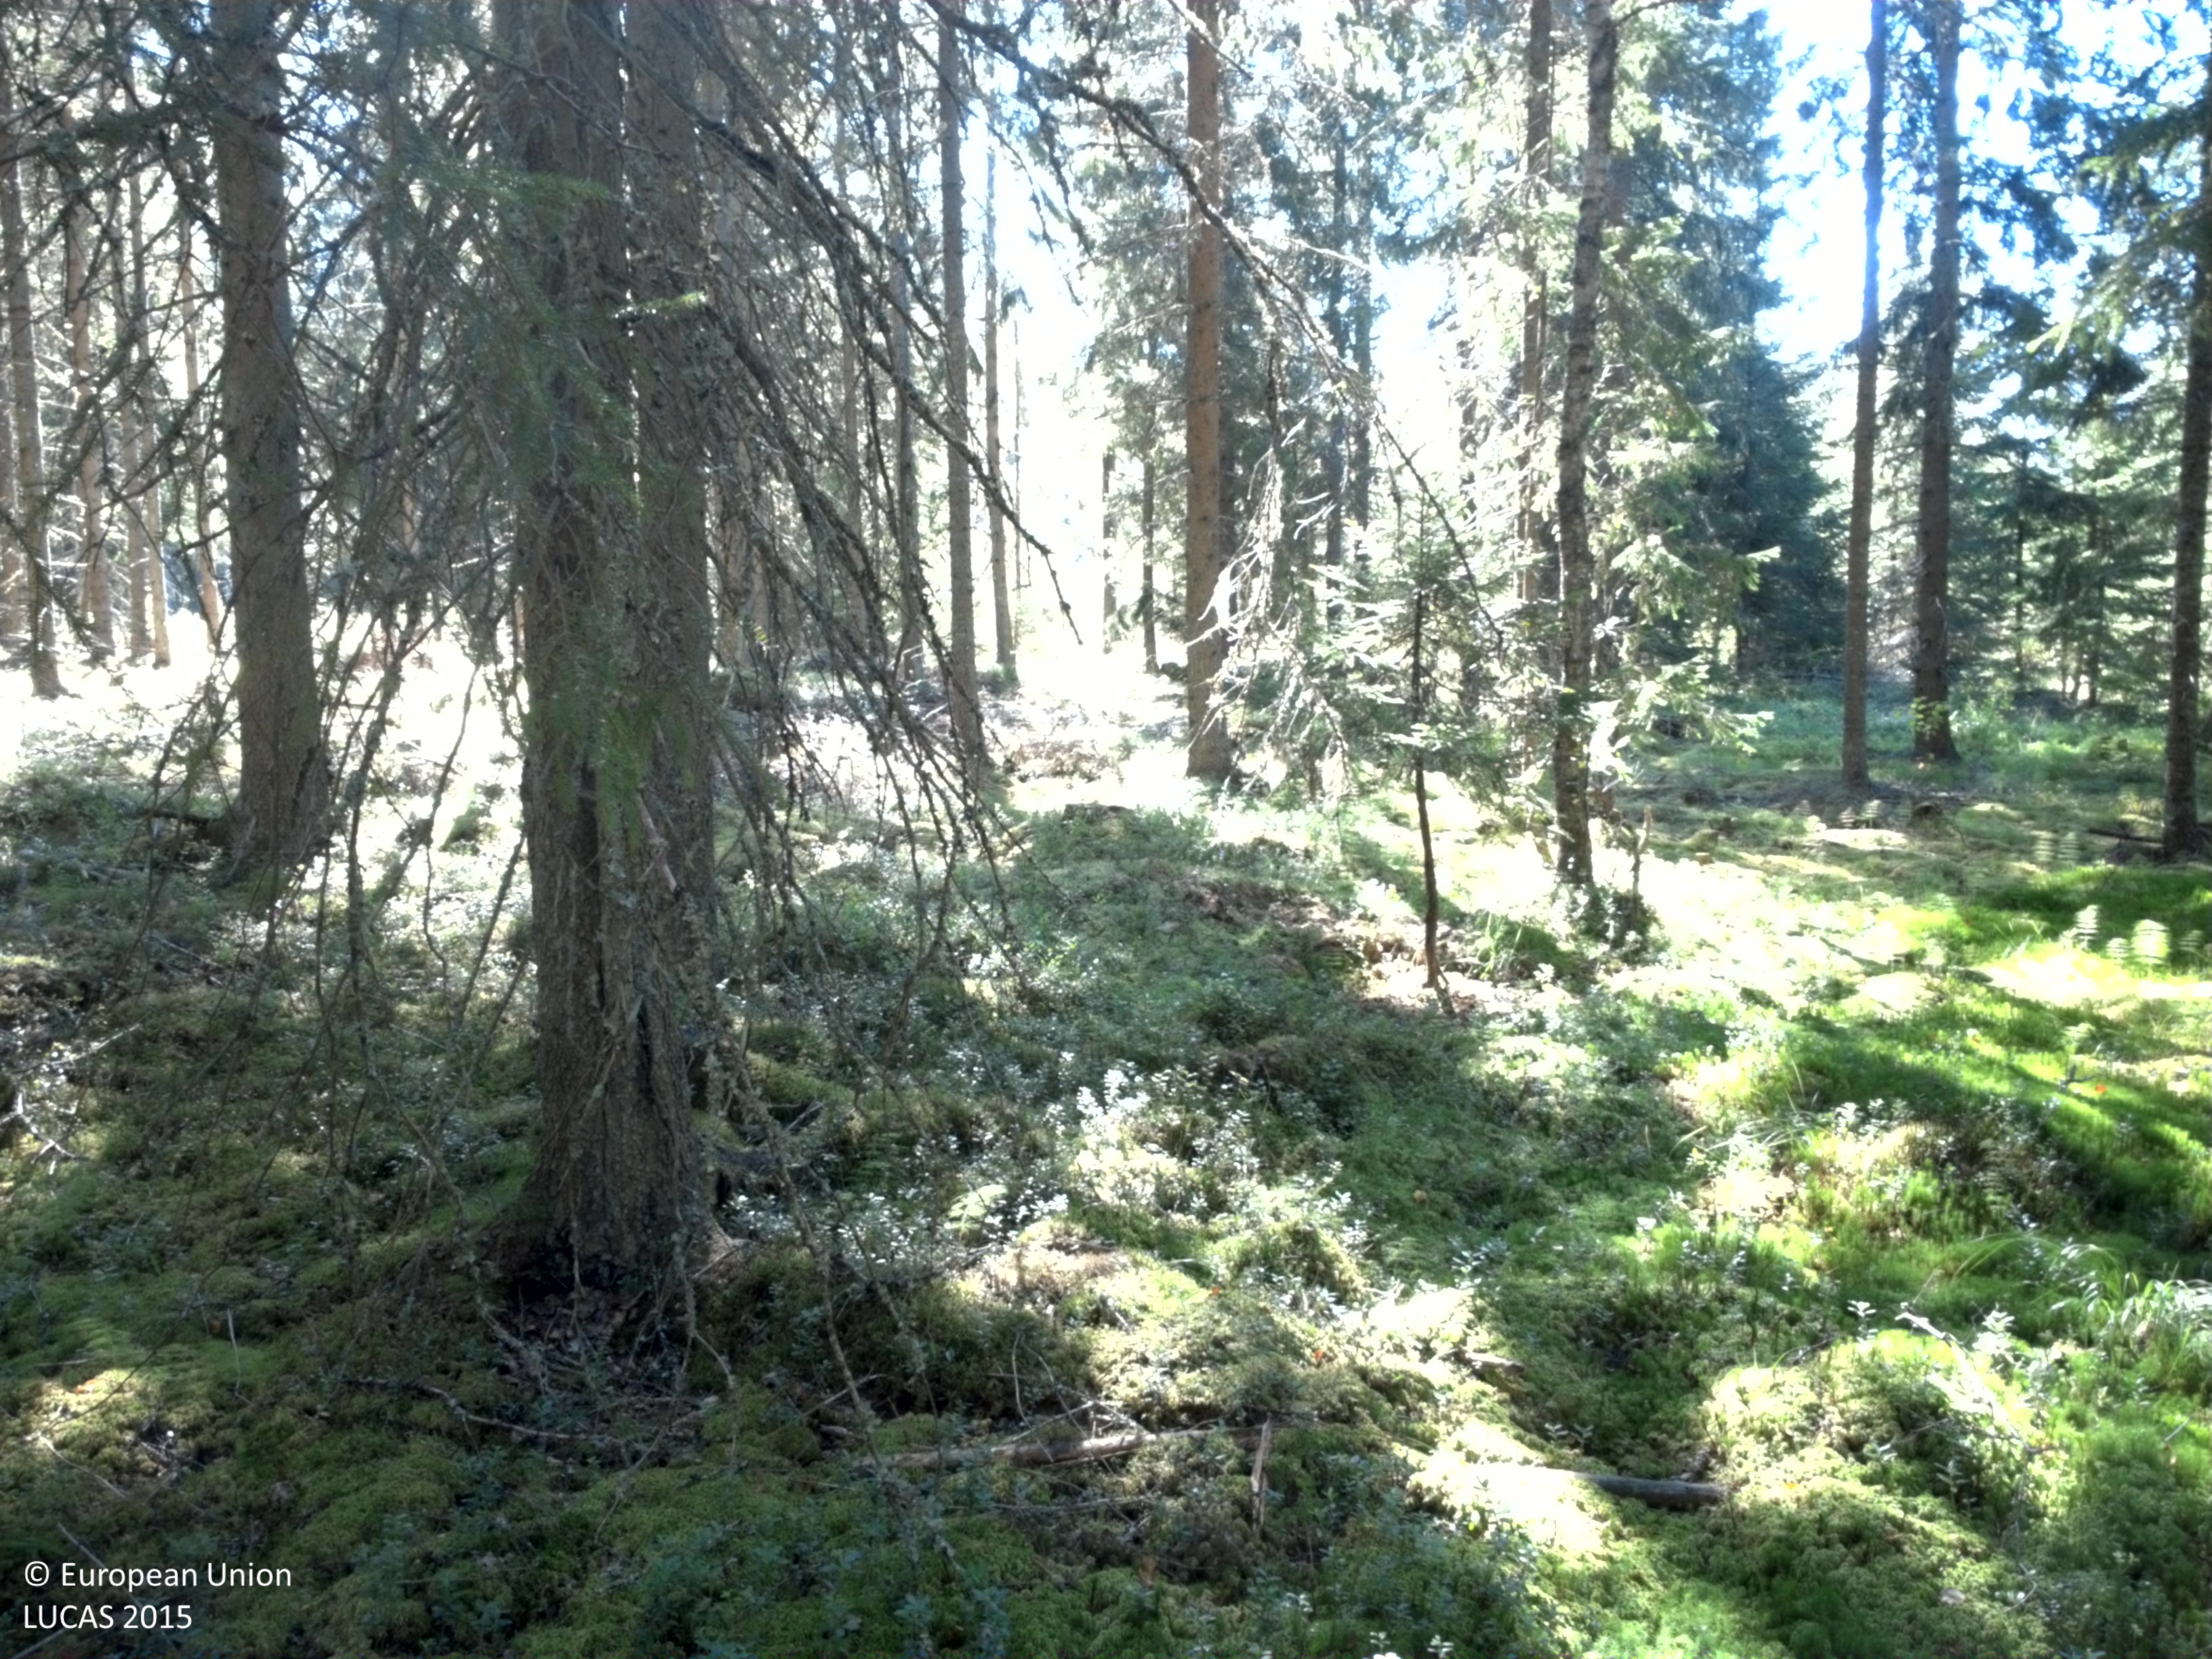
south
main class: Woodland
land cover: Spruce dominated coniferous woodland
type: boreal forest
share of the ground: > 75 %
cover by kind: coniferous forest trees 75 %, lichens and mosses 15 %, shrubs 10 %
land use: Forestry
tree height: > 5 m
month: August
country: SE
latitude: 59.6764
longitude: 15.9396
